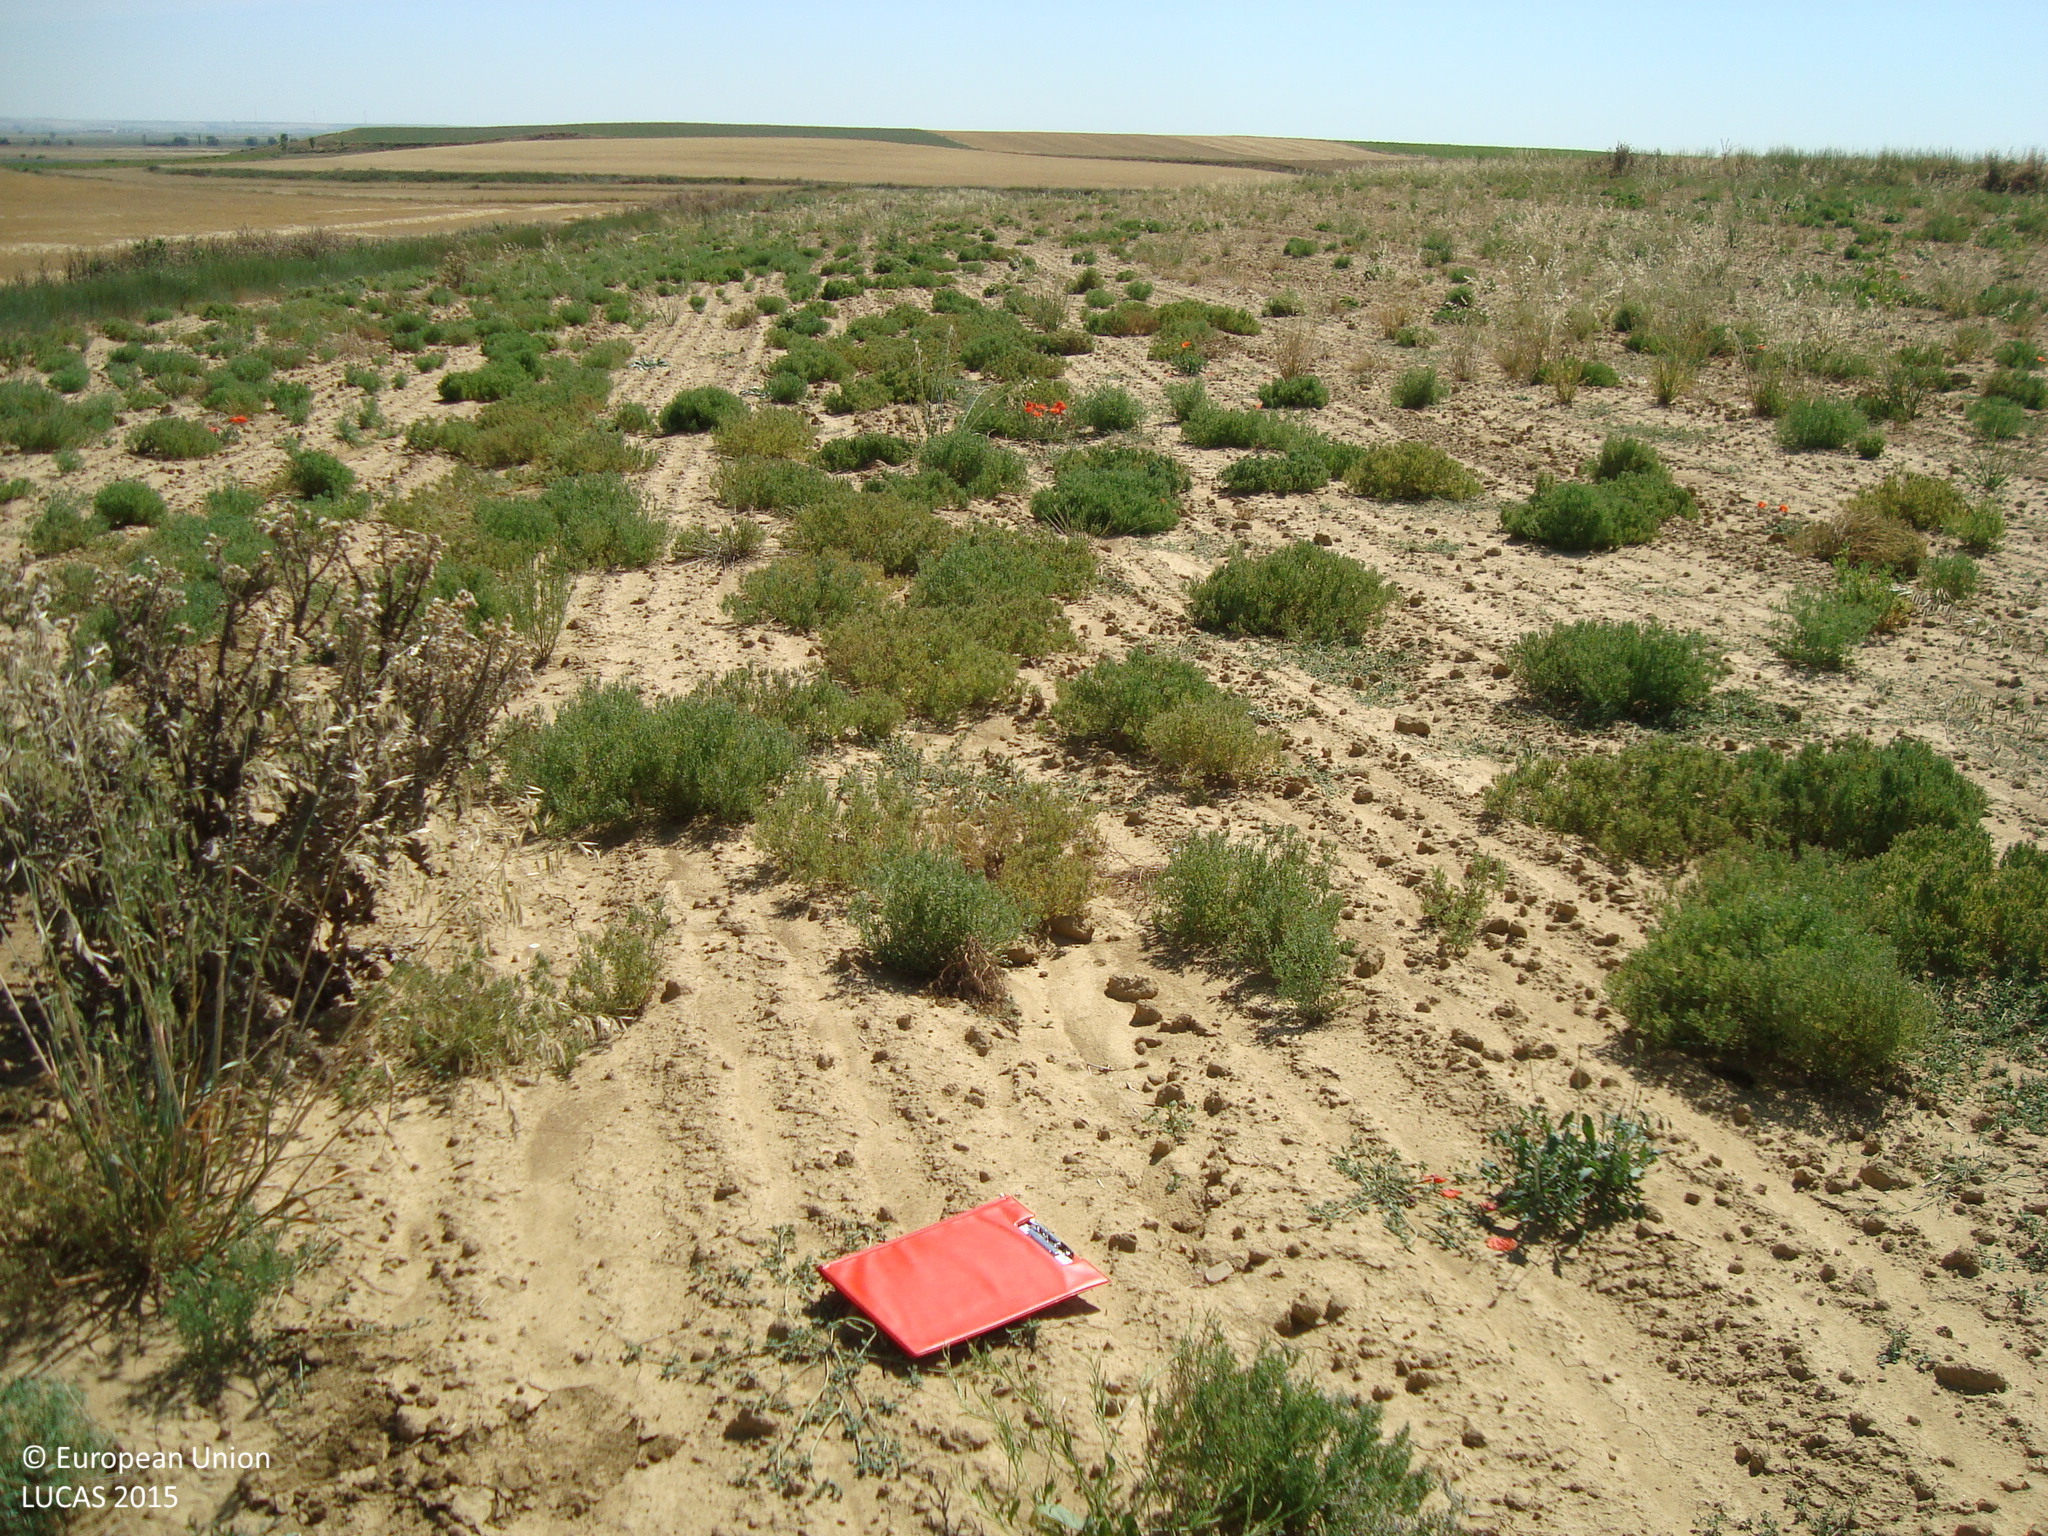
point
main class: Grassland
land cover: Spontaneously vegetated surfaces
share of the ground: 25 - 50 %
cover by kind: unconsolidated bare surface 60 %, herbaceous plants 40 %
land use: Abandoned areas
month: July
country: ES
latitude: 42.0576
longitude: -4.7810
